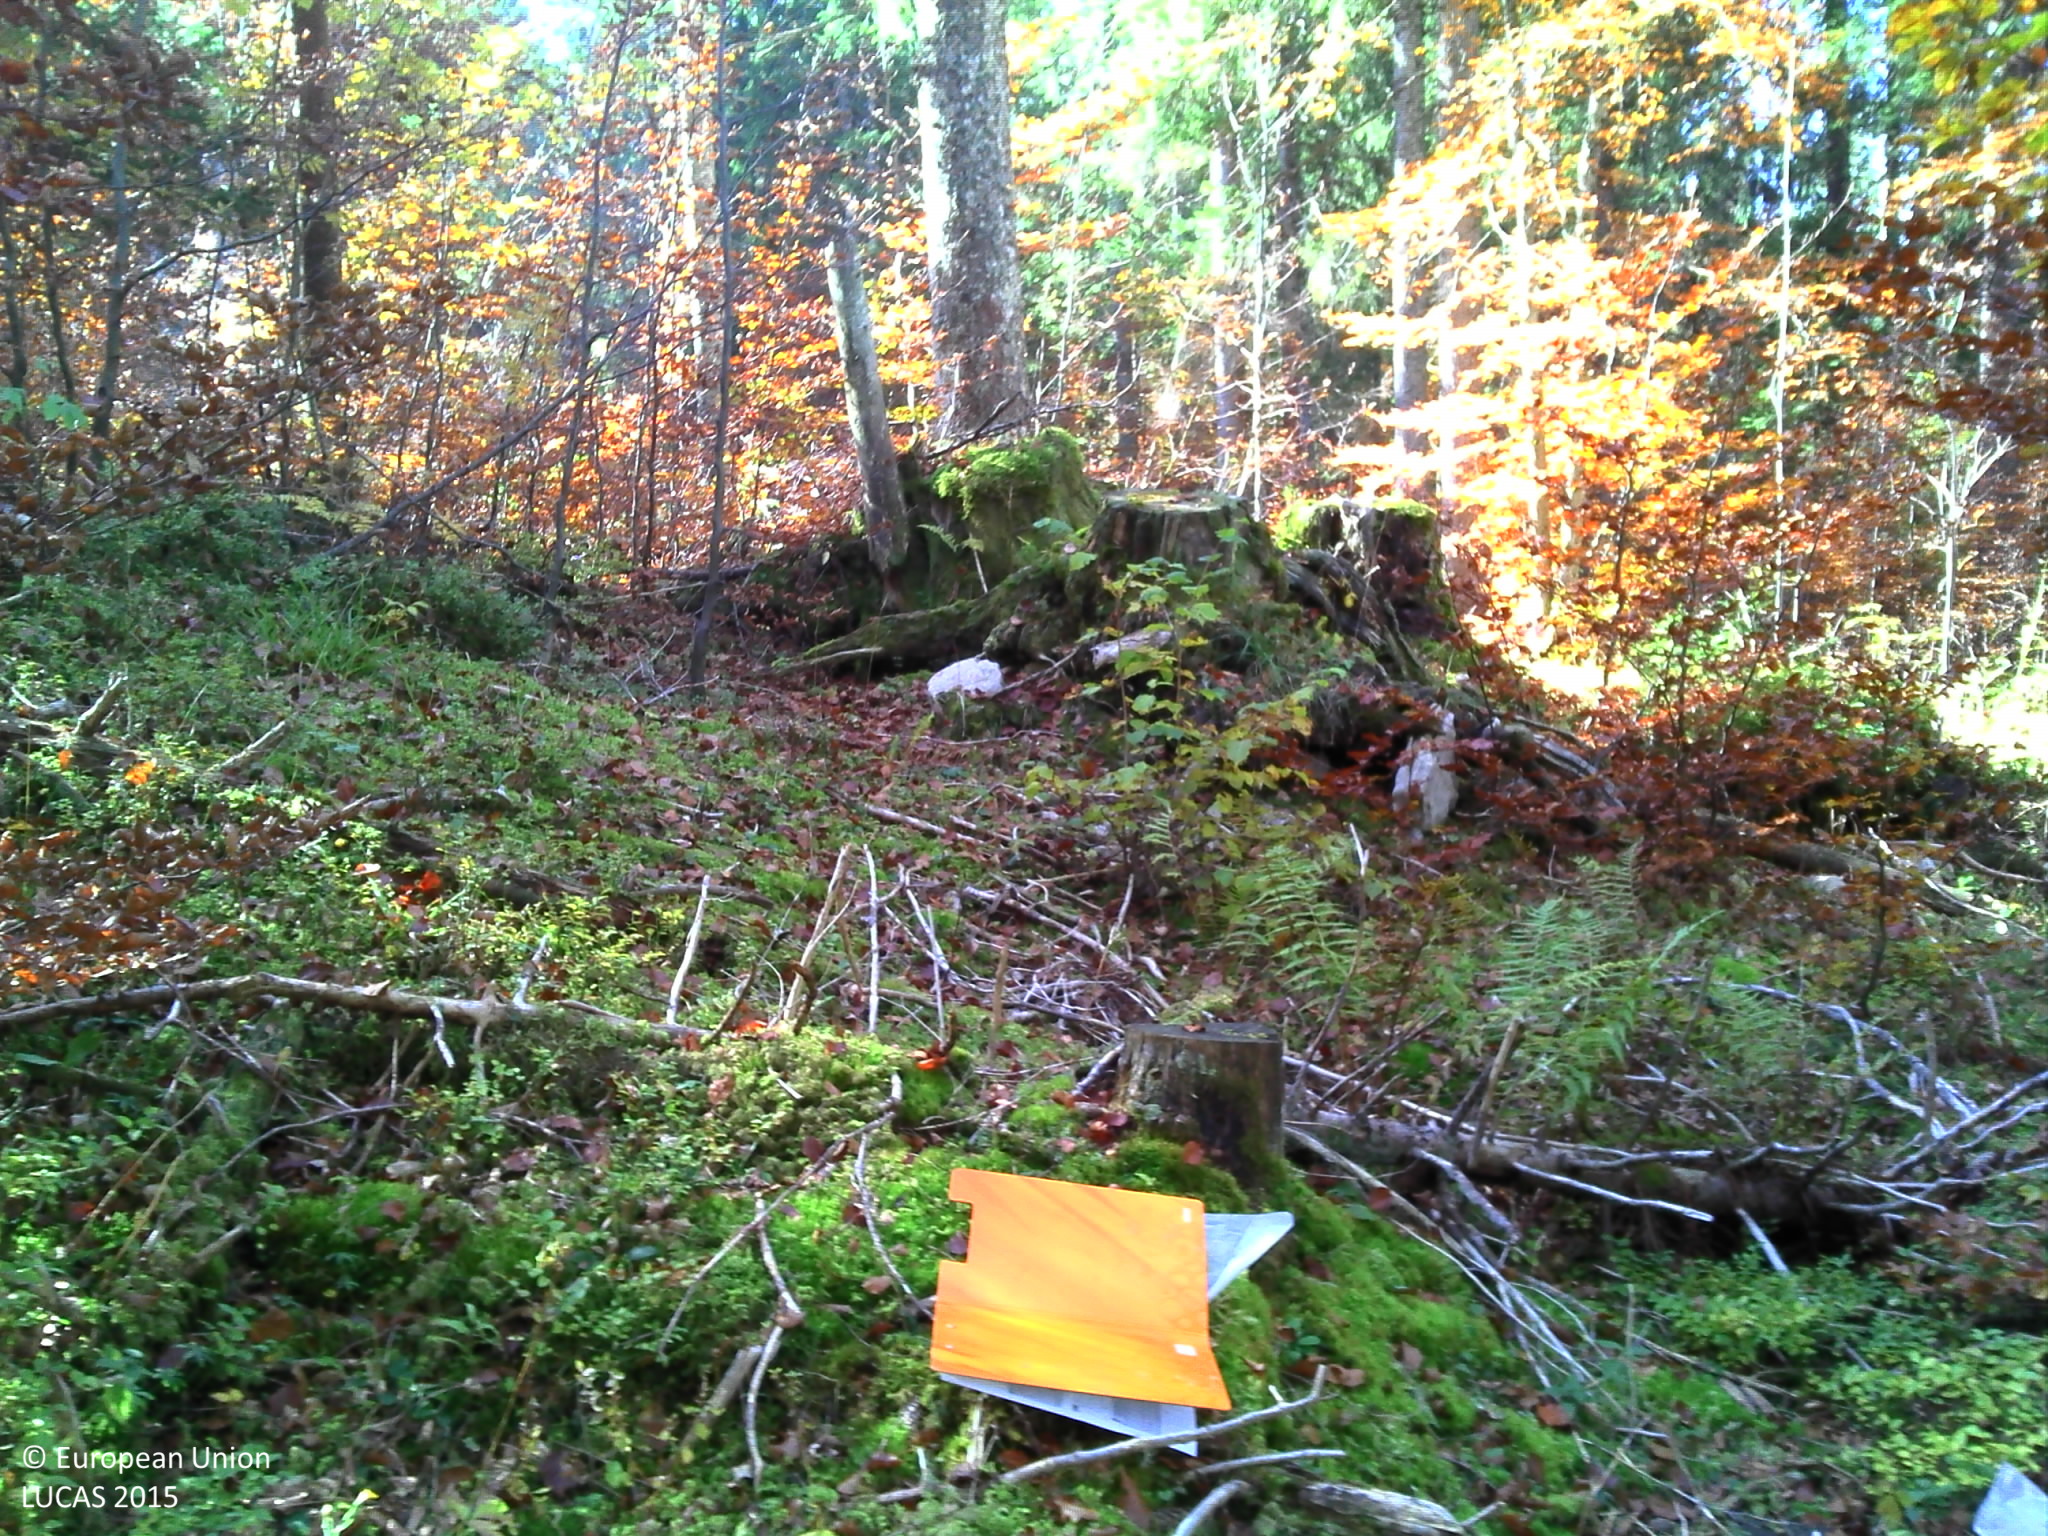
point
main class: Woodland
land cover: Spruce dominated mixed woodland
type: mountainous beech forest
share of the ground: > 75 %
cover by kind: broadleaved forest trees 40 %, coniferous forest trees 30 %, herbaceous plants 10 %, lichens and mosses 10 %, consolidated bare surface 5 %, unconsolidated bare surface 5 %
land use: Forestry
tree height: > 5 m
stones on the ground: 10 - 25 %
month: October
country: FR
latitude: 46.6245
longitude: 6.1501
